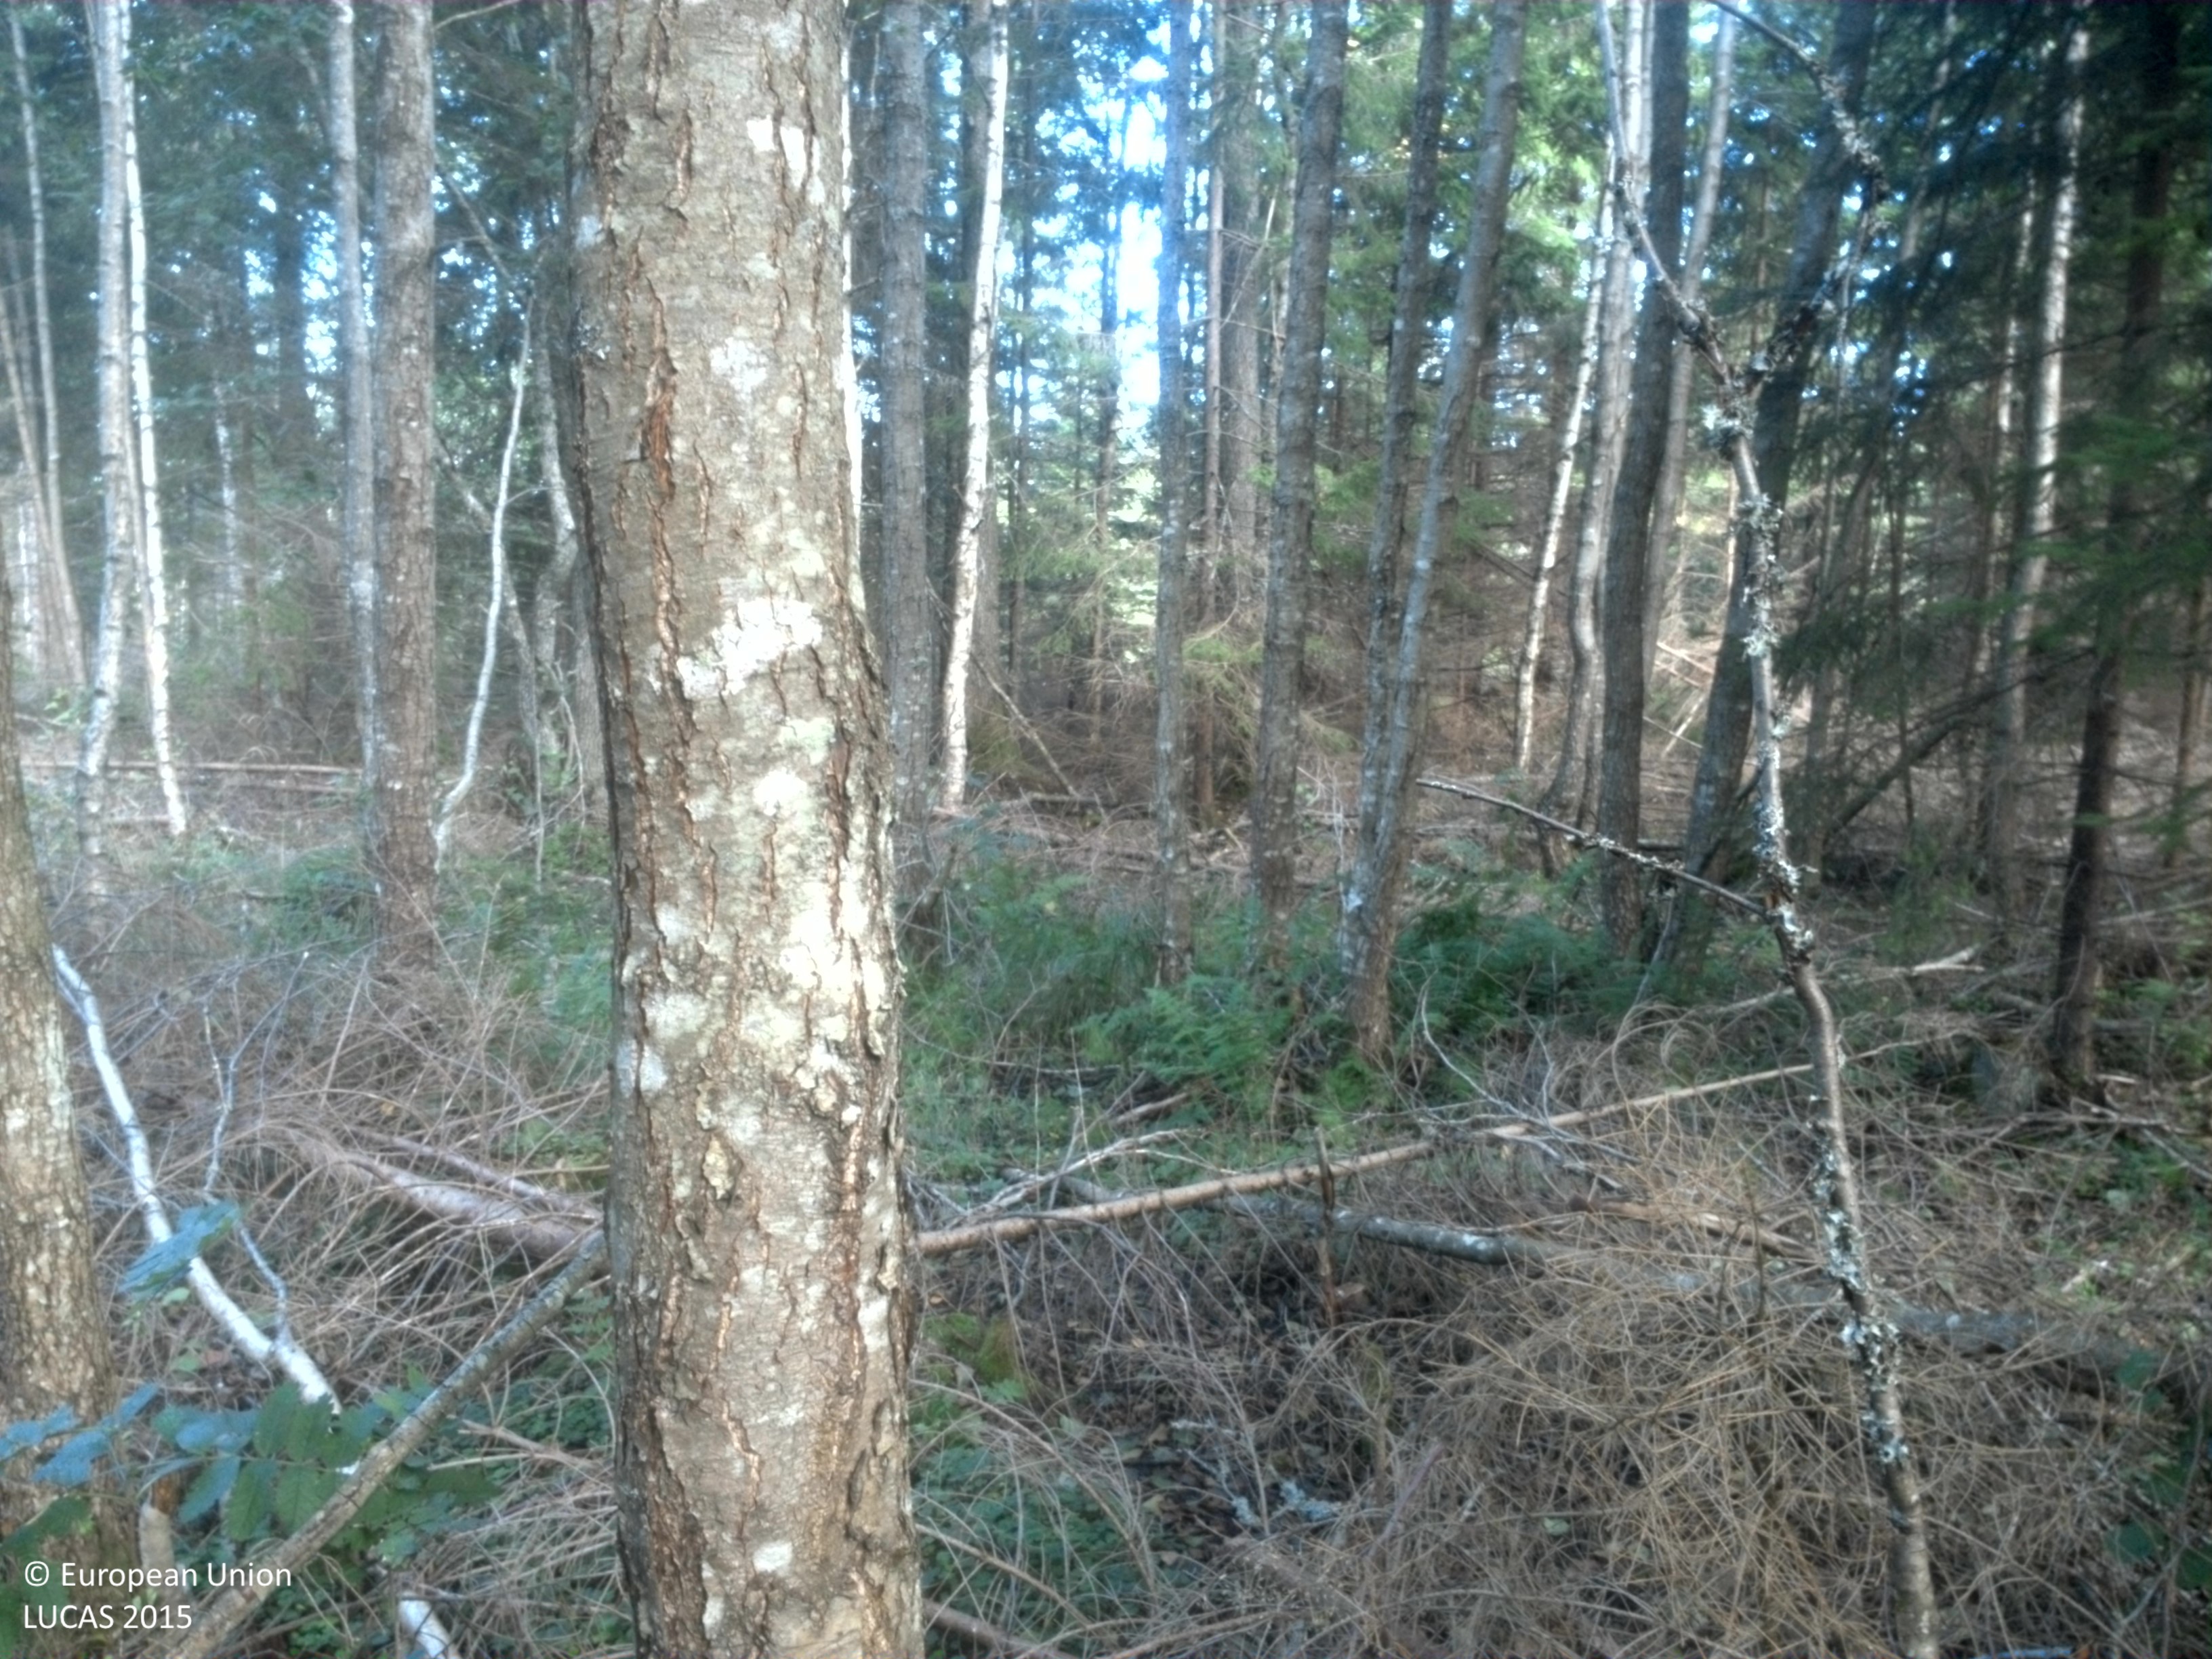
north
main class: Woodland
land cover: Spruce dominated mixed woodland
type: boreal forest
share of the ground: 50 - 75 %
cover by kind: coniferous forest trees 45 %, broadleaved forest trees 25 %, shrubs 15 %, lichens and mosses 10 %, herbaceous plants 5 %
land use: Forestry
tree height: > 5 m
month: September
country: SE
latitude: 59.5598
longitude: 15.7068
